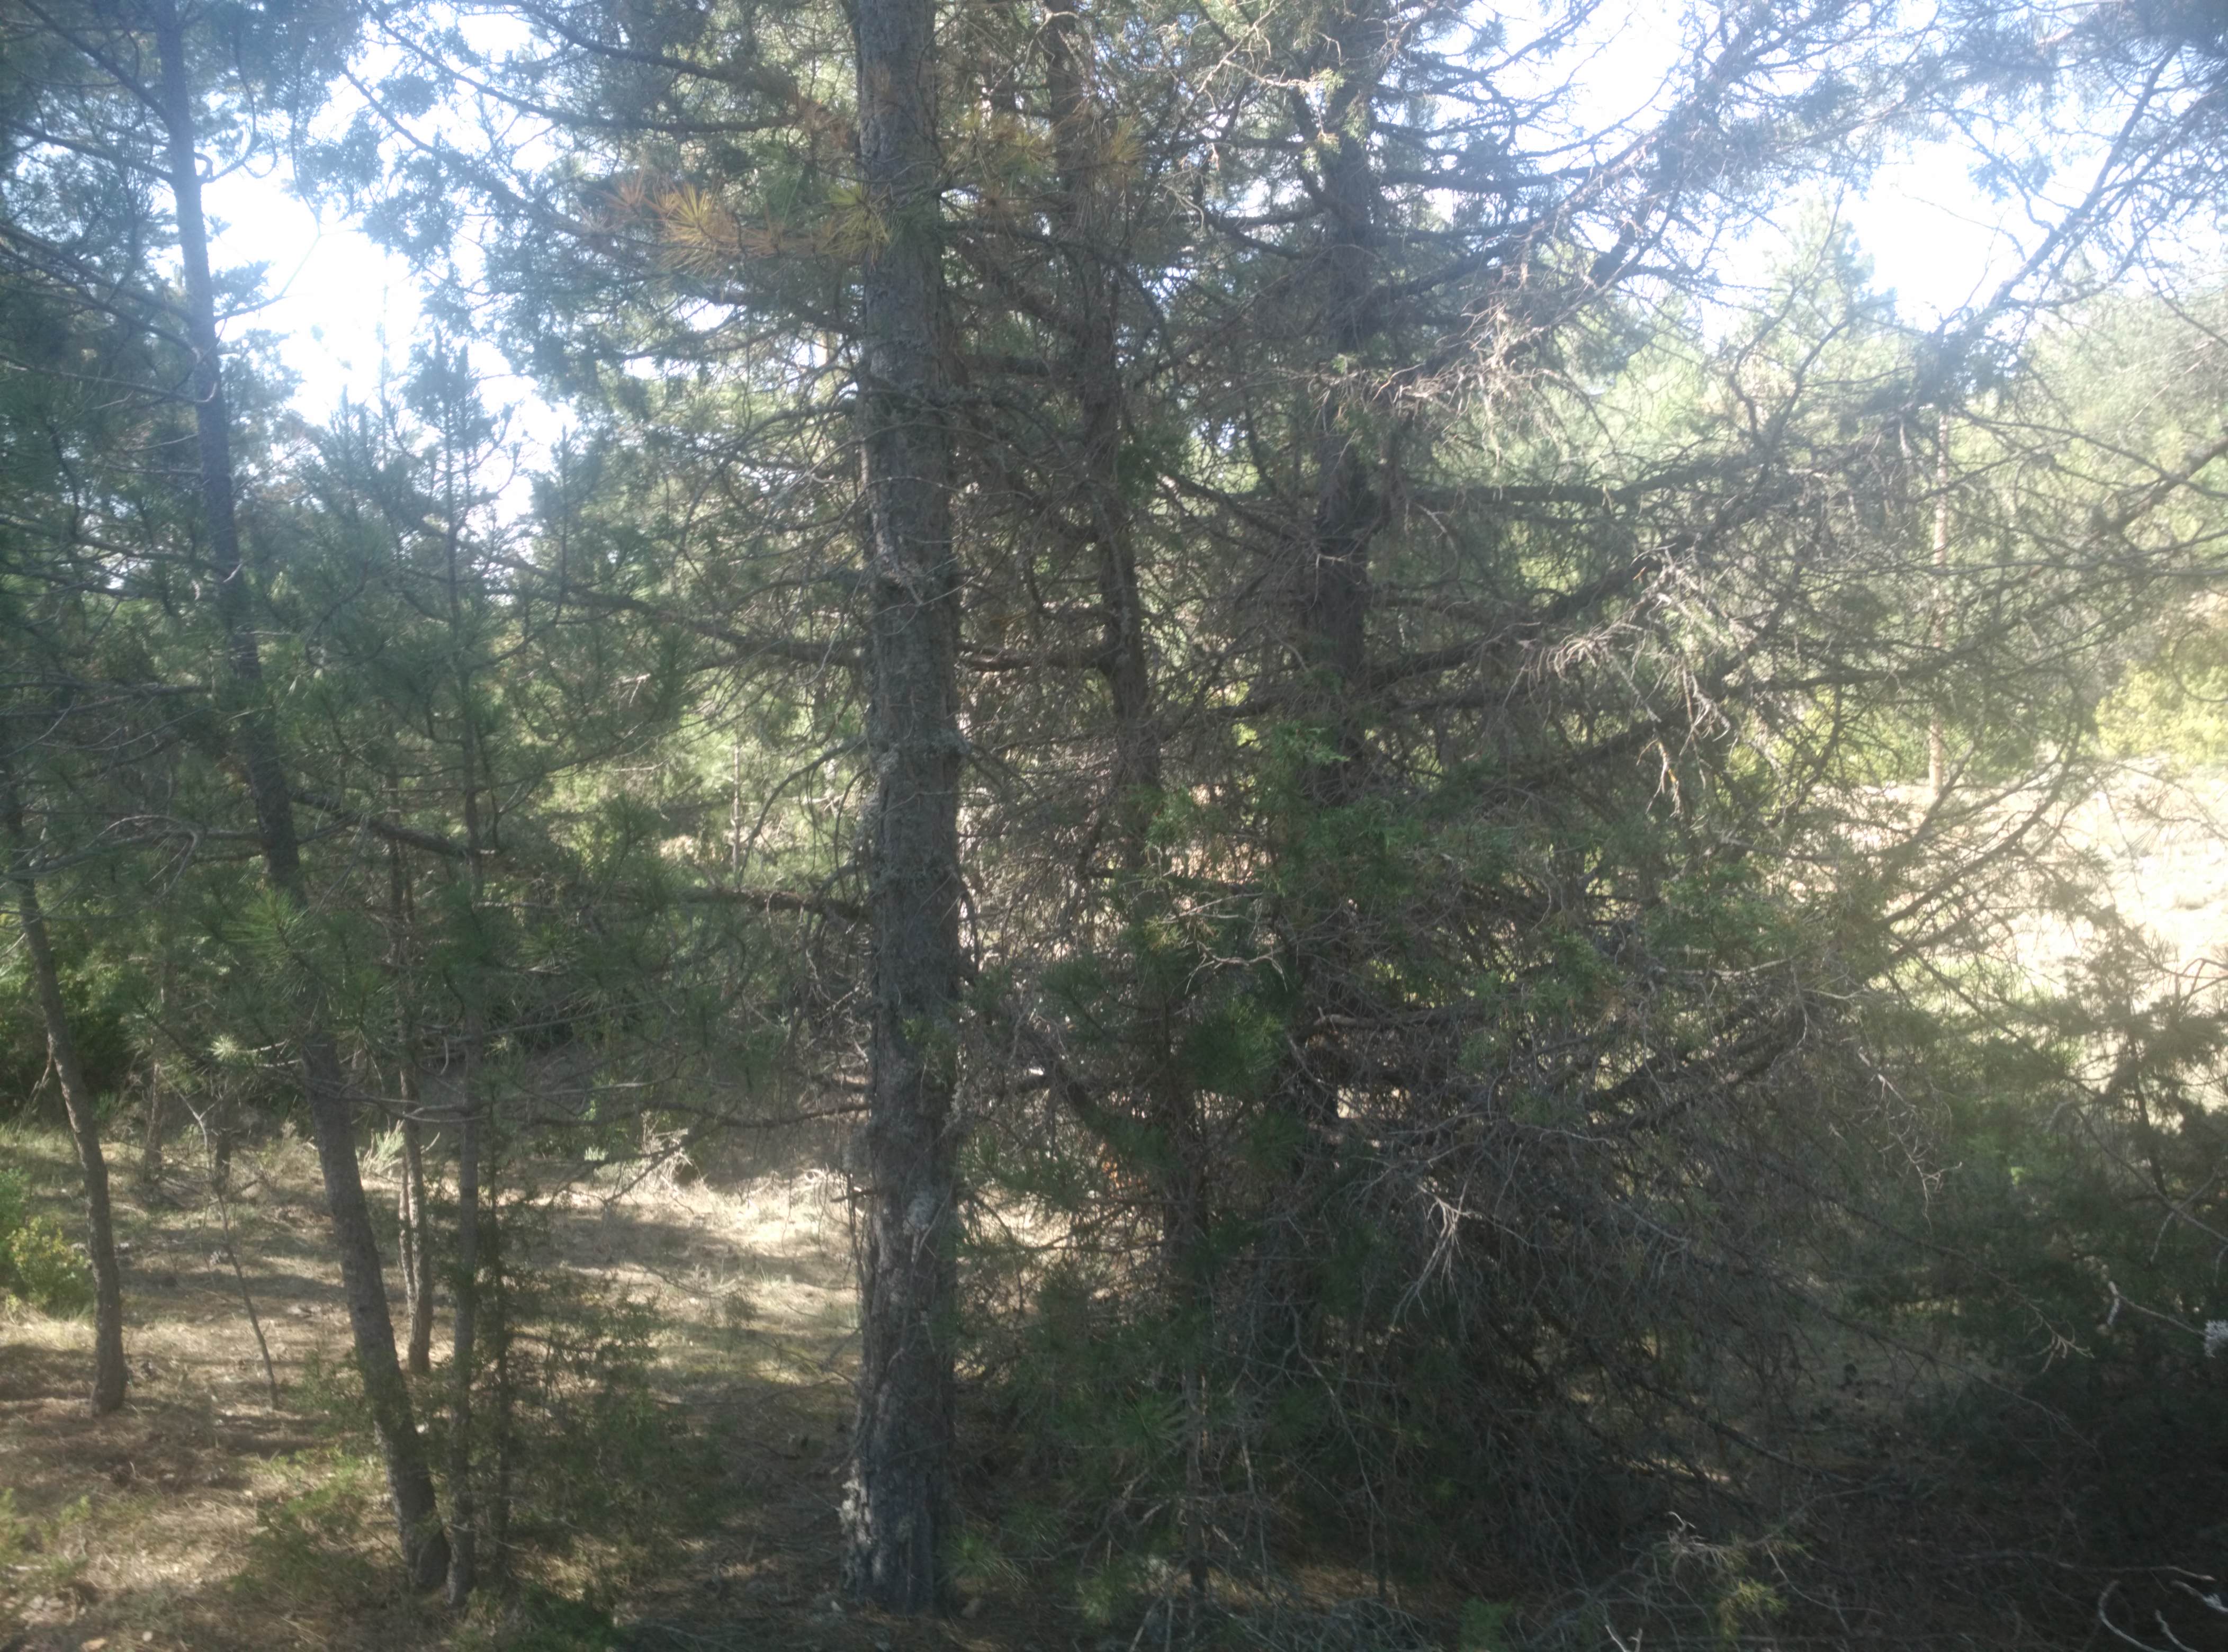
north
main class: Woodland
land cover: Pine dominated coniferous woodland
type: coniferous forest of the mediterranean region
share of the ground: 25 - 50 %
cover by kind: coniferous forest trees 40 %, unconsolidated bare surface 40 %, shrubs 15 %, herbaceous plants 5 %
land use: Semi-natural and natural areas not in use
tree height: > 5 m
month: June
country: ES
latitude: 40.6264
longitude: -1.8295
